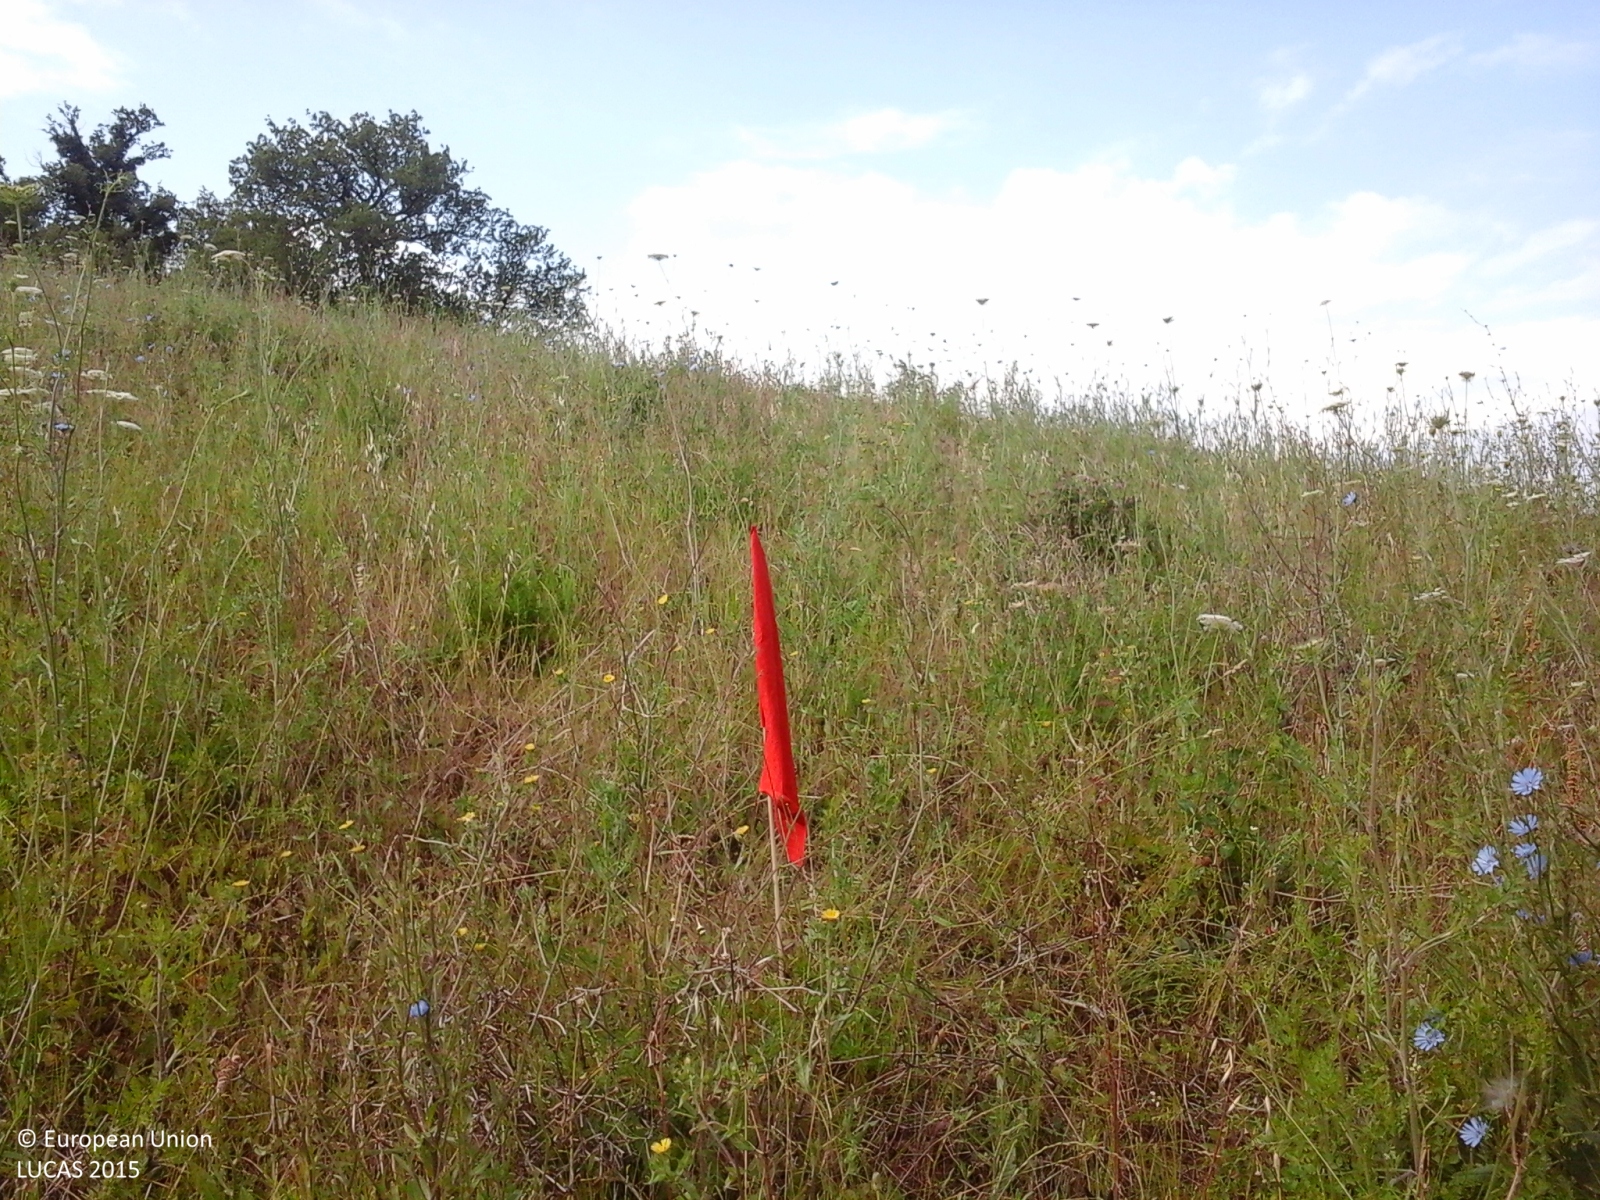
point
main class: Grassland
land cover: Spontaneously vegetated surfaces
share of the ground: > 75 %
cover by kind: herbaceous plants 95 %, shrubs 5 %
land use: Agriculture (excluding fallow land and kitchen gardens)
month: June
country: IT
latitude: 43.1997
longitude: 13.2034
